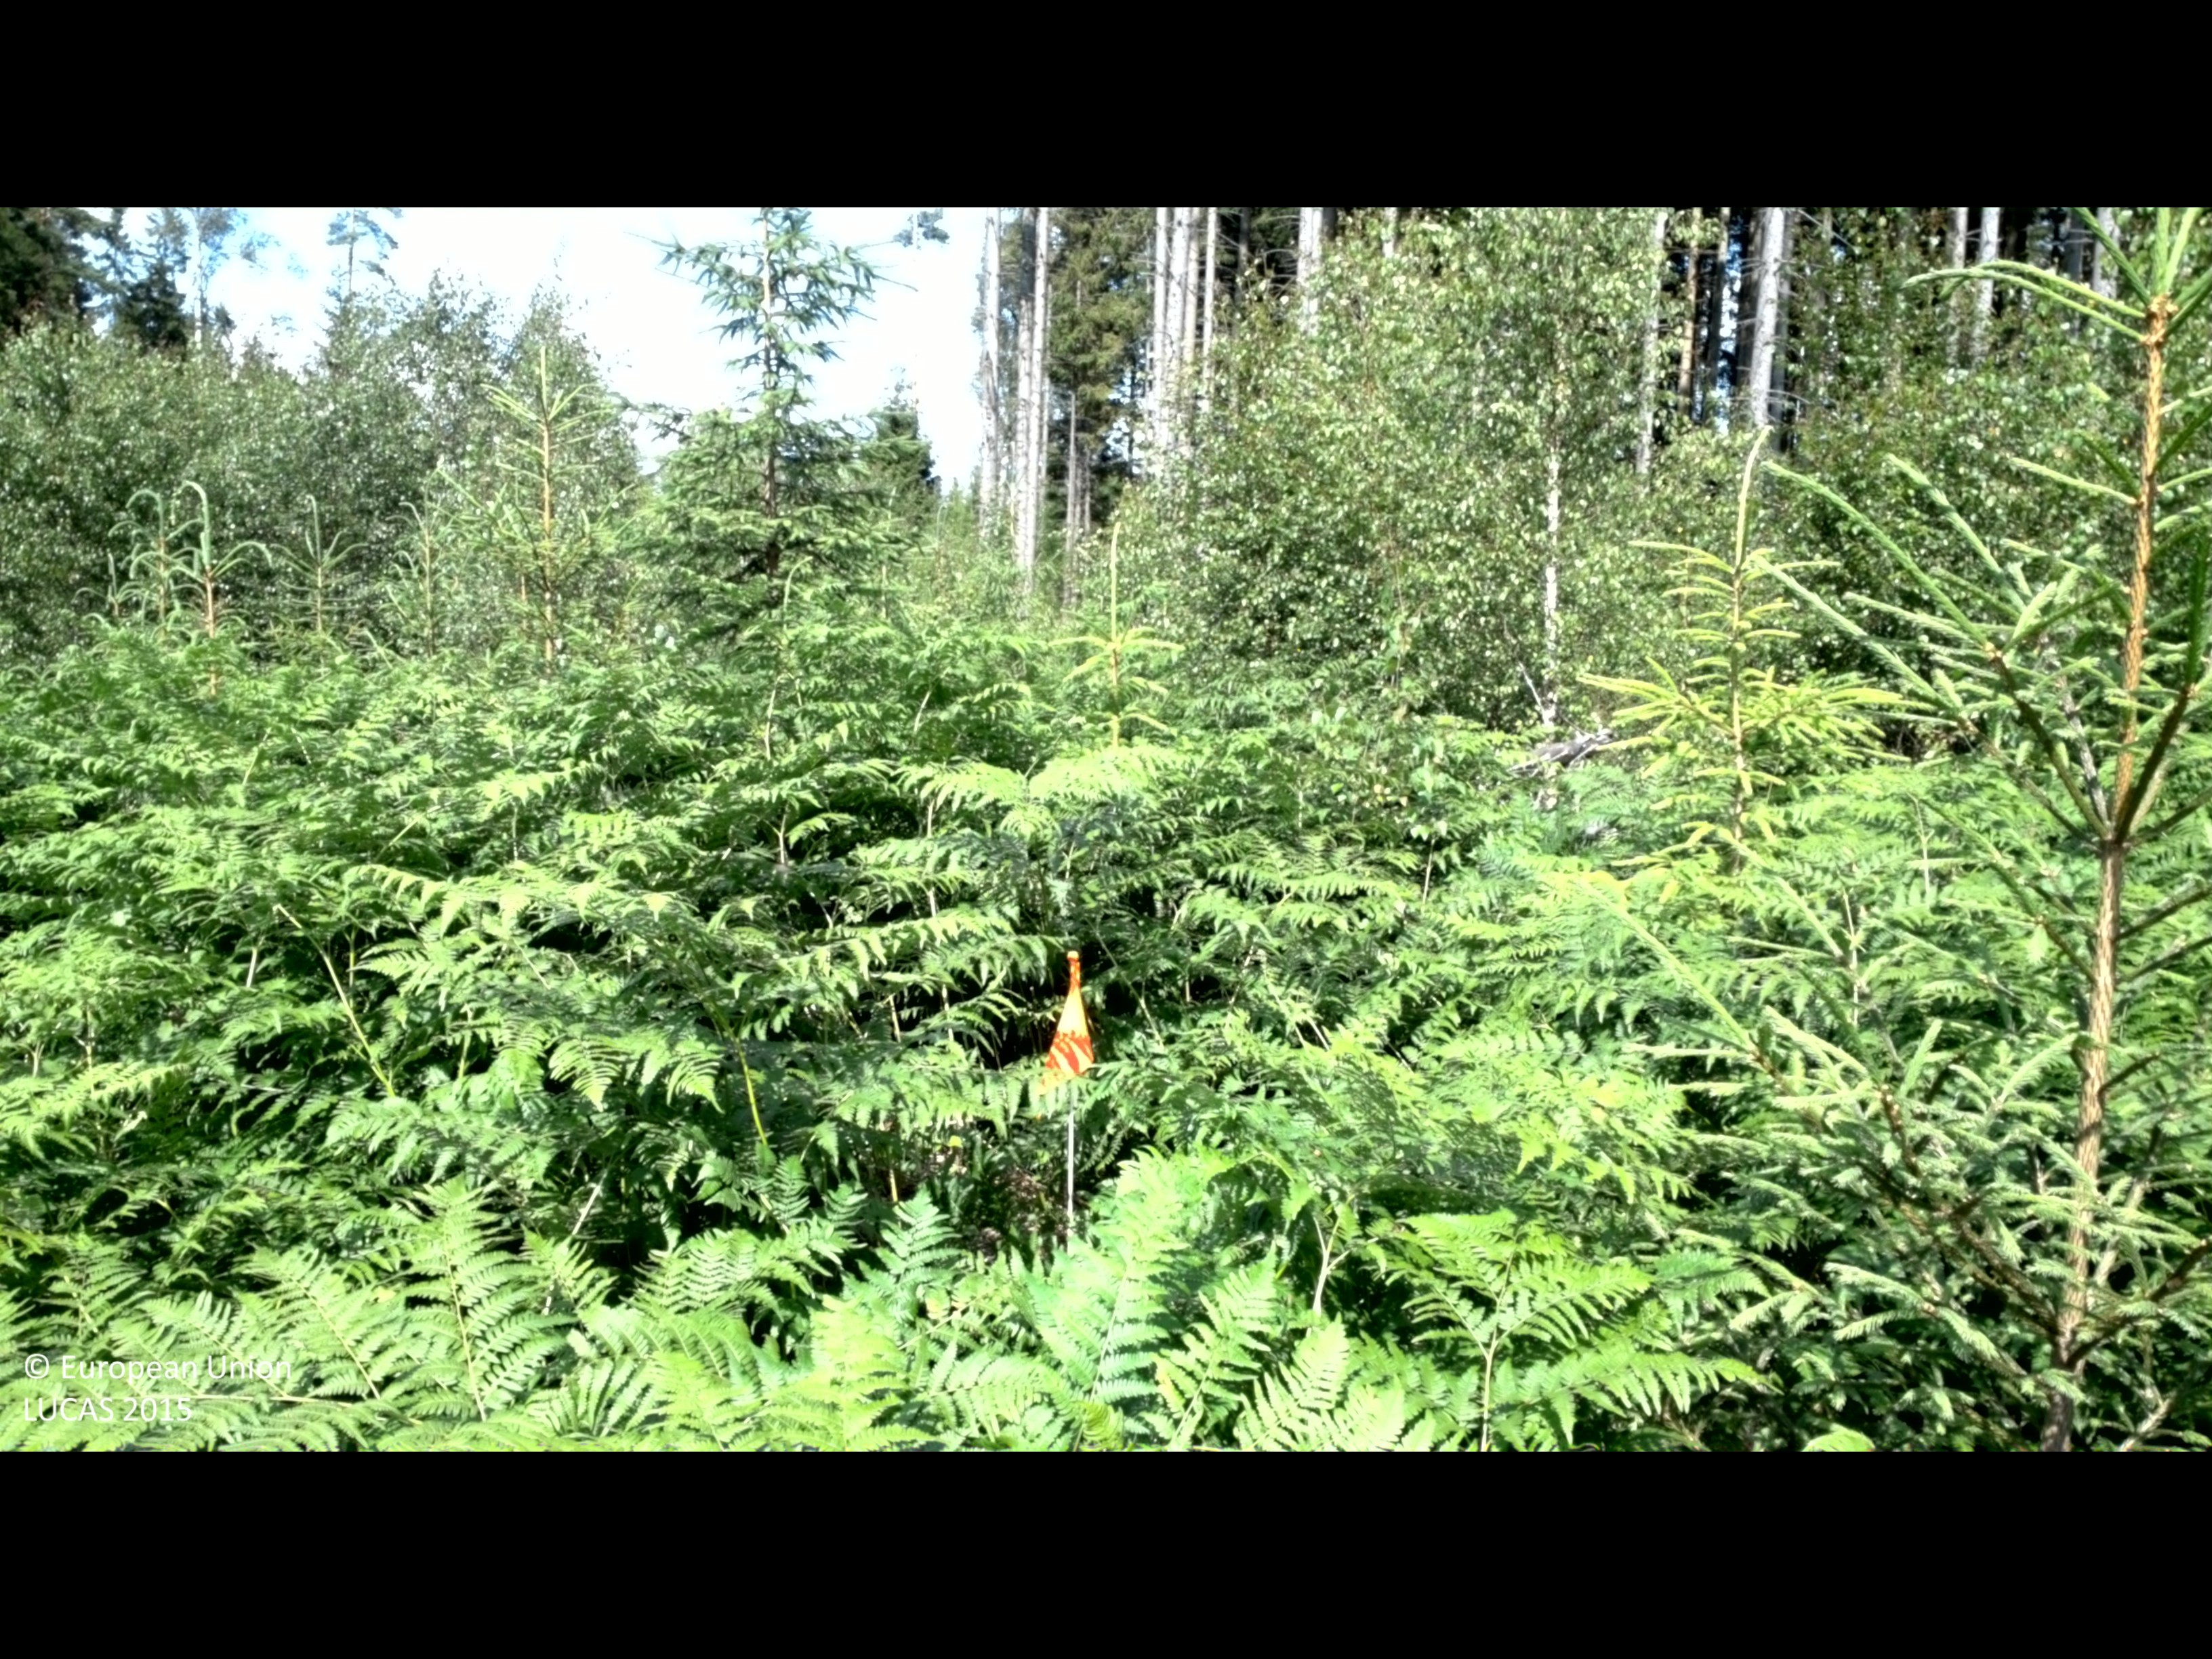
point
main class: Woodland
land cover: Broadleaved woodland
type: boreal forest
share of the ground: 50 - 75 %
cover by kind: broadleaved forest trees 55 %, herbaceous plants 20 %, coniferous forest trees 15 %, shrubs 10 %
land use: Forestry
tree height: < 5 m
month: July
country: SE
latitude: 56.4949
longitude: 14.2692
